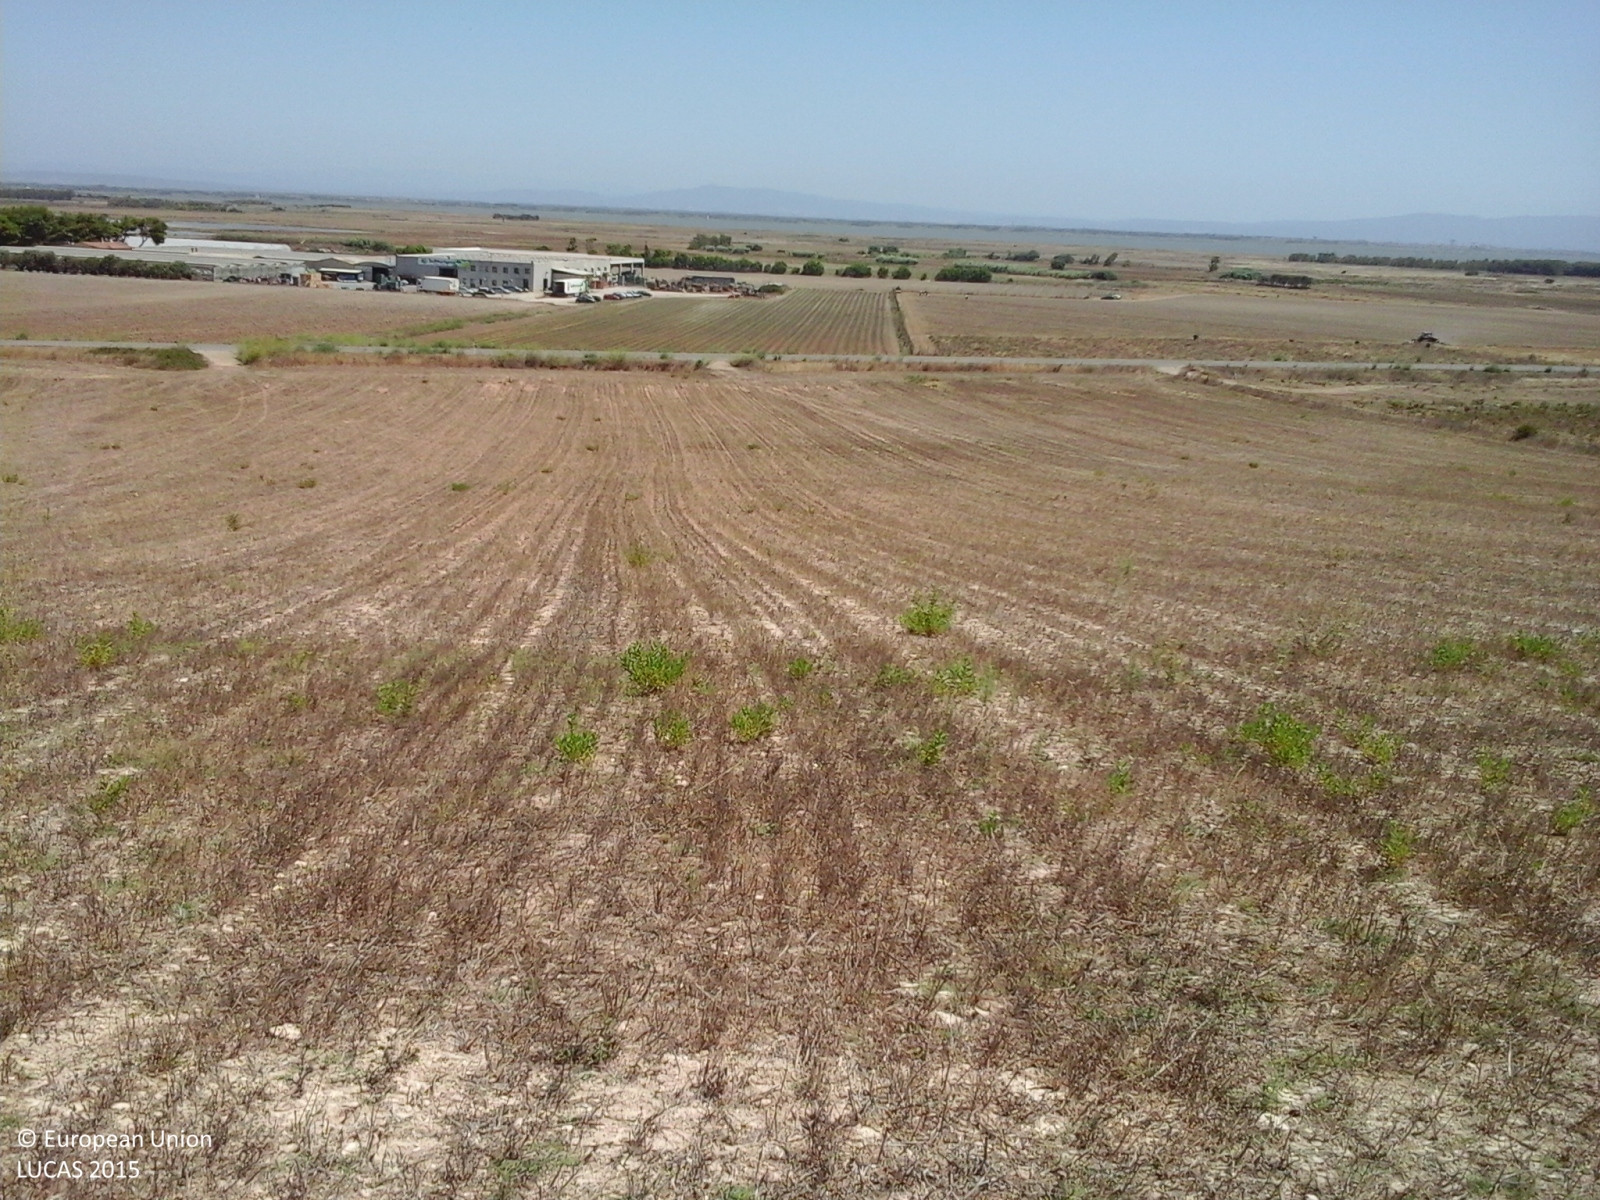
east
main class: Cropland
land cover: Mixed cereals for fodder
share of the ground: > 75 %
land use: Agriculture (excluding fallow land and kitchen gardens)
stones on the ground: < 10 %
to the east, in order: Mixed cereals for fodder; Grass margins; Paved roads, cycling and walking lanes; Grass margins; Other fresh vegetables
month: July
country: IT
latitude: 39.9654
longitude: 8.4514
